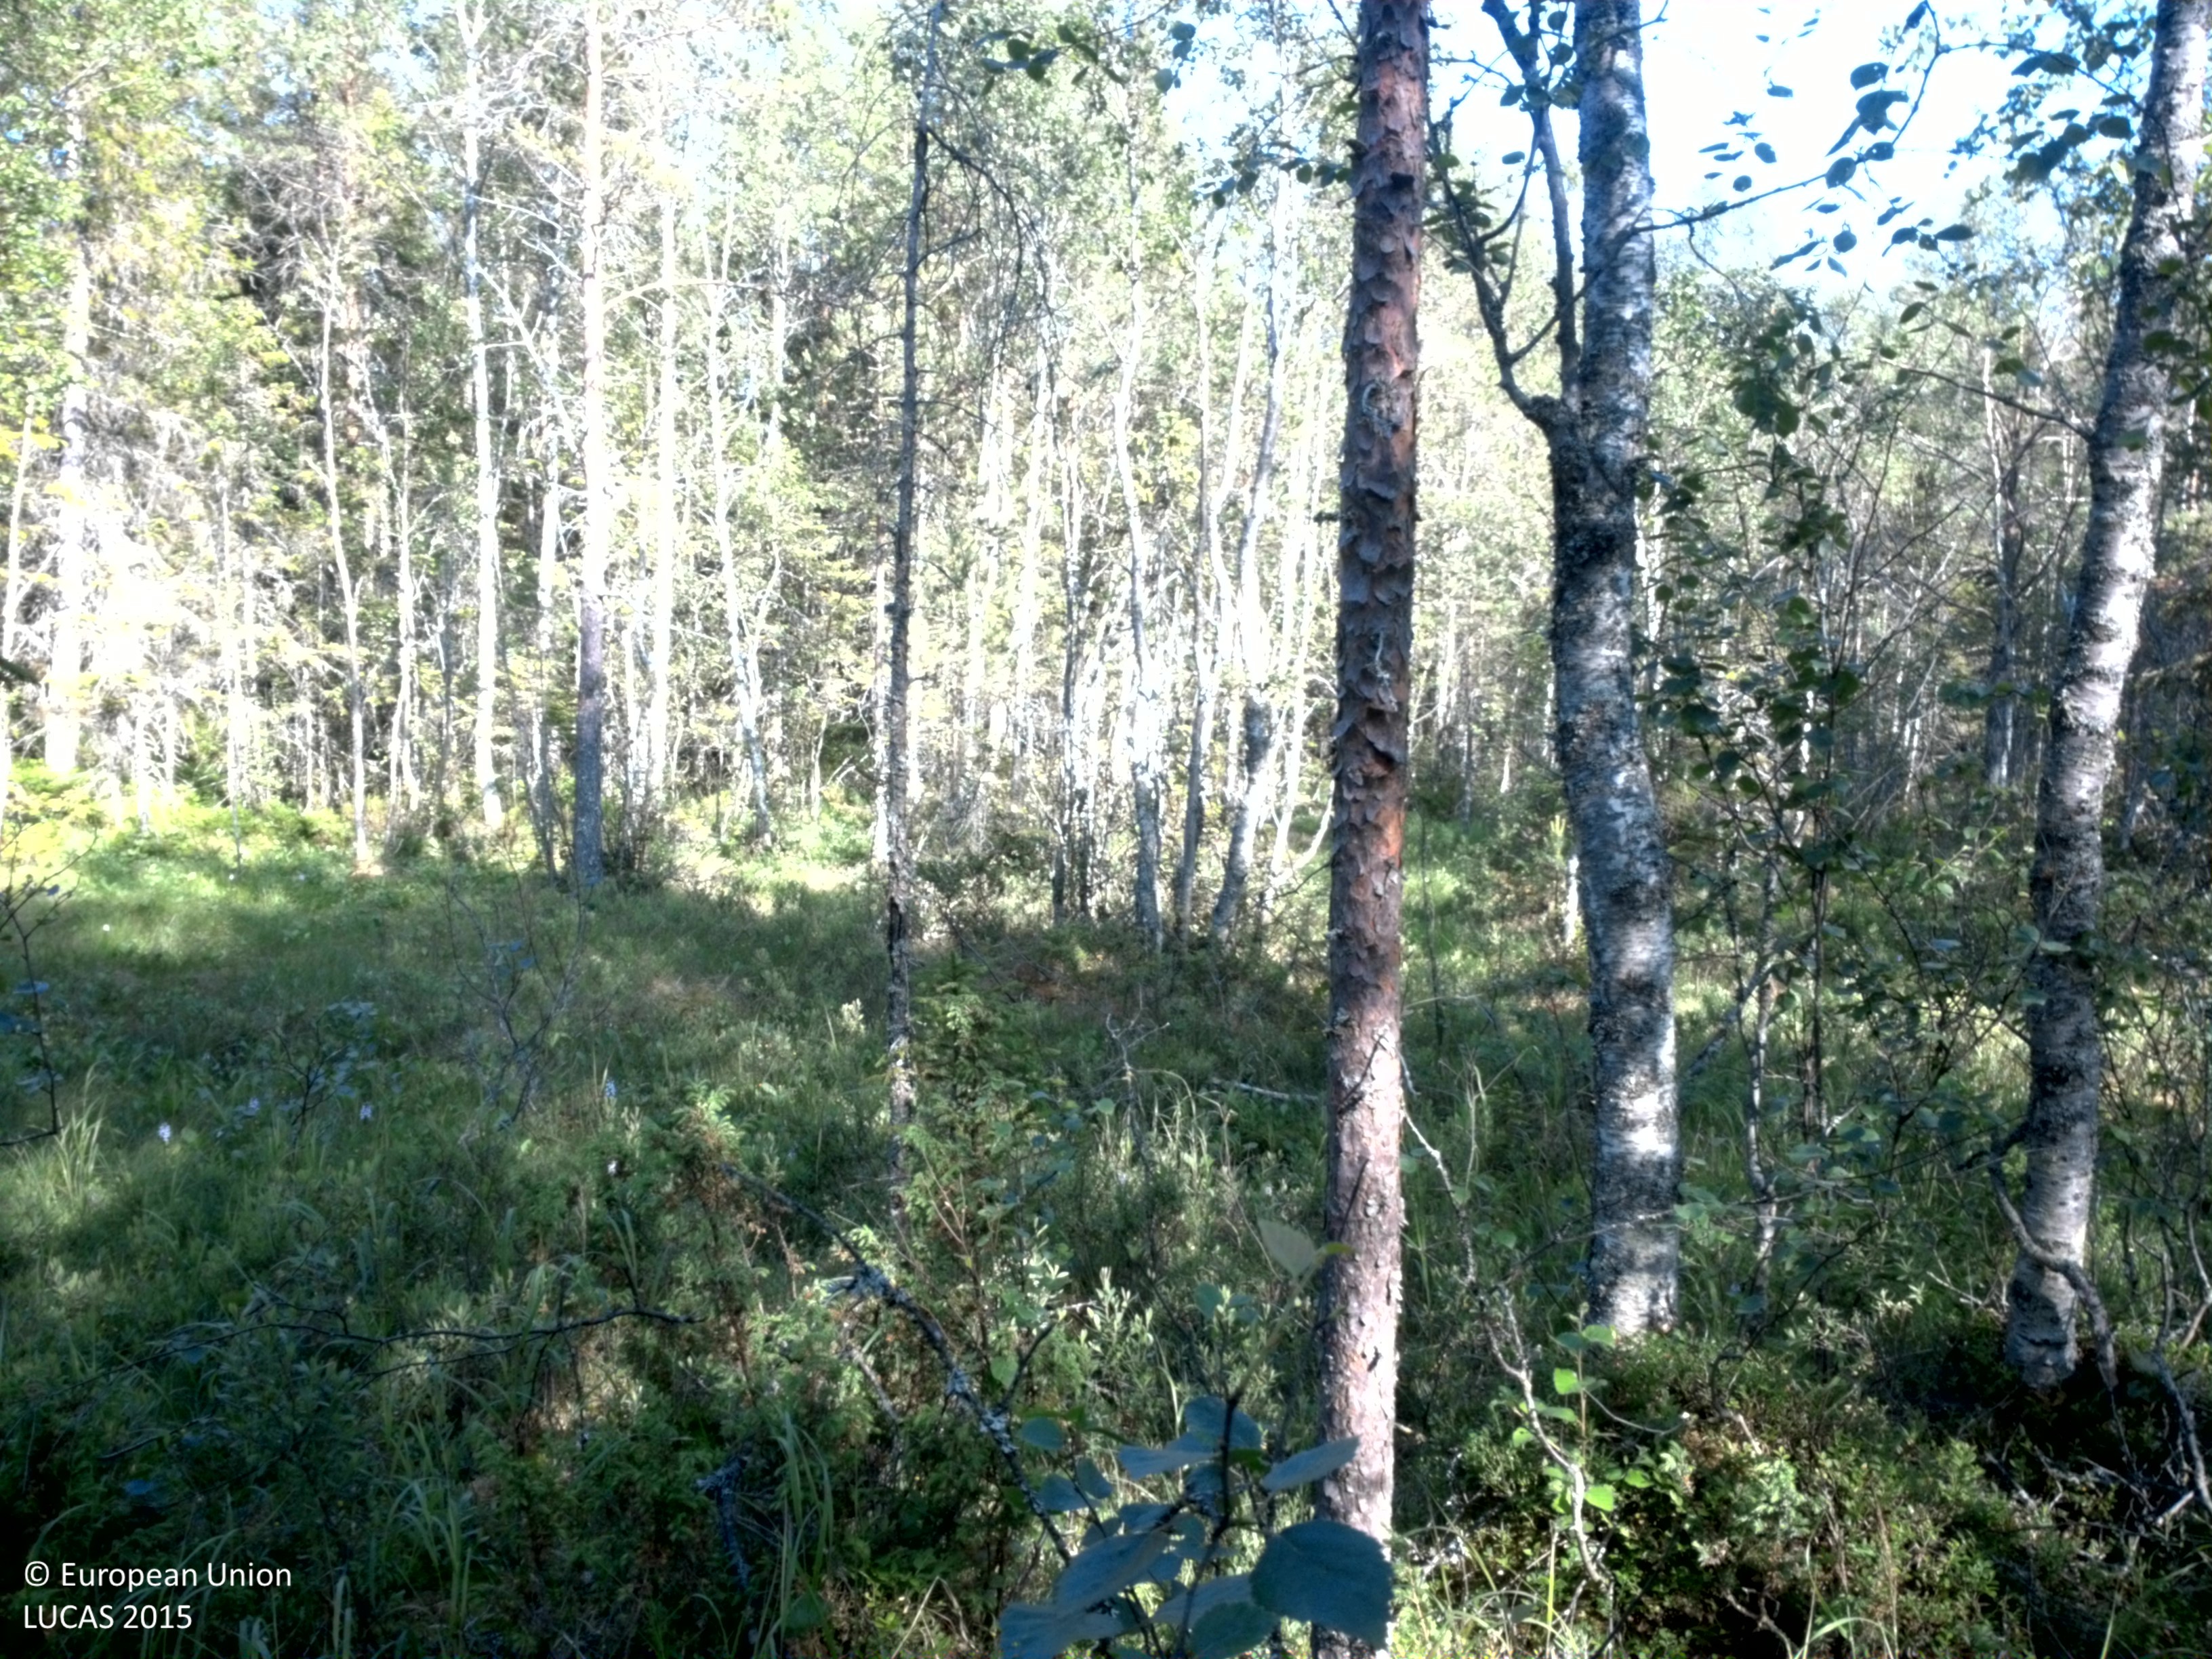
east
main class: Woodland
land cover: Spruce dominated mixed woodland
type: boreal forest
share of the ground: 50 - 75 %
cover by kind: coniferous forest trees 45 %, shrubs 30 %, broadleaved forest trees 15 %, lichens and mosses 10 %
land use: Forestry
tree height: > 5 m
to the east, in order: Spruce dominated mixed woodland; Pine dominated mixed woodland; Spruce dominated mixed woodland; Spruce dominated coniferous woodland
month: July
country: SE
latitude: 64.2750
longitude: 21.1972
